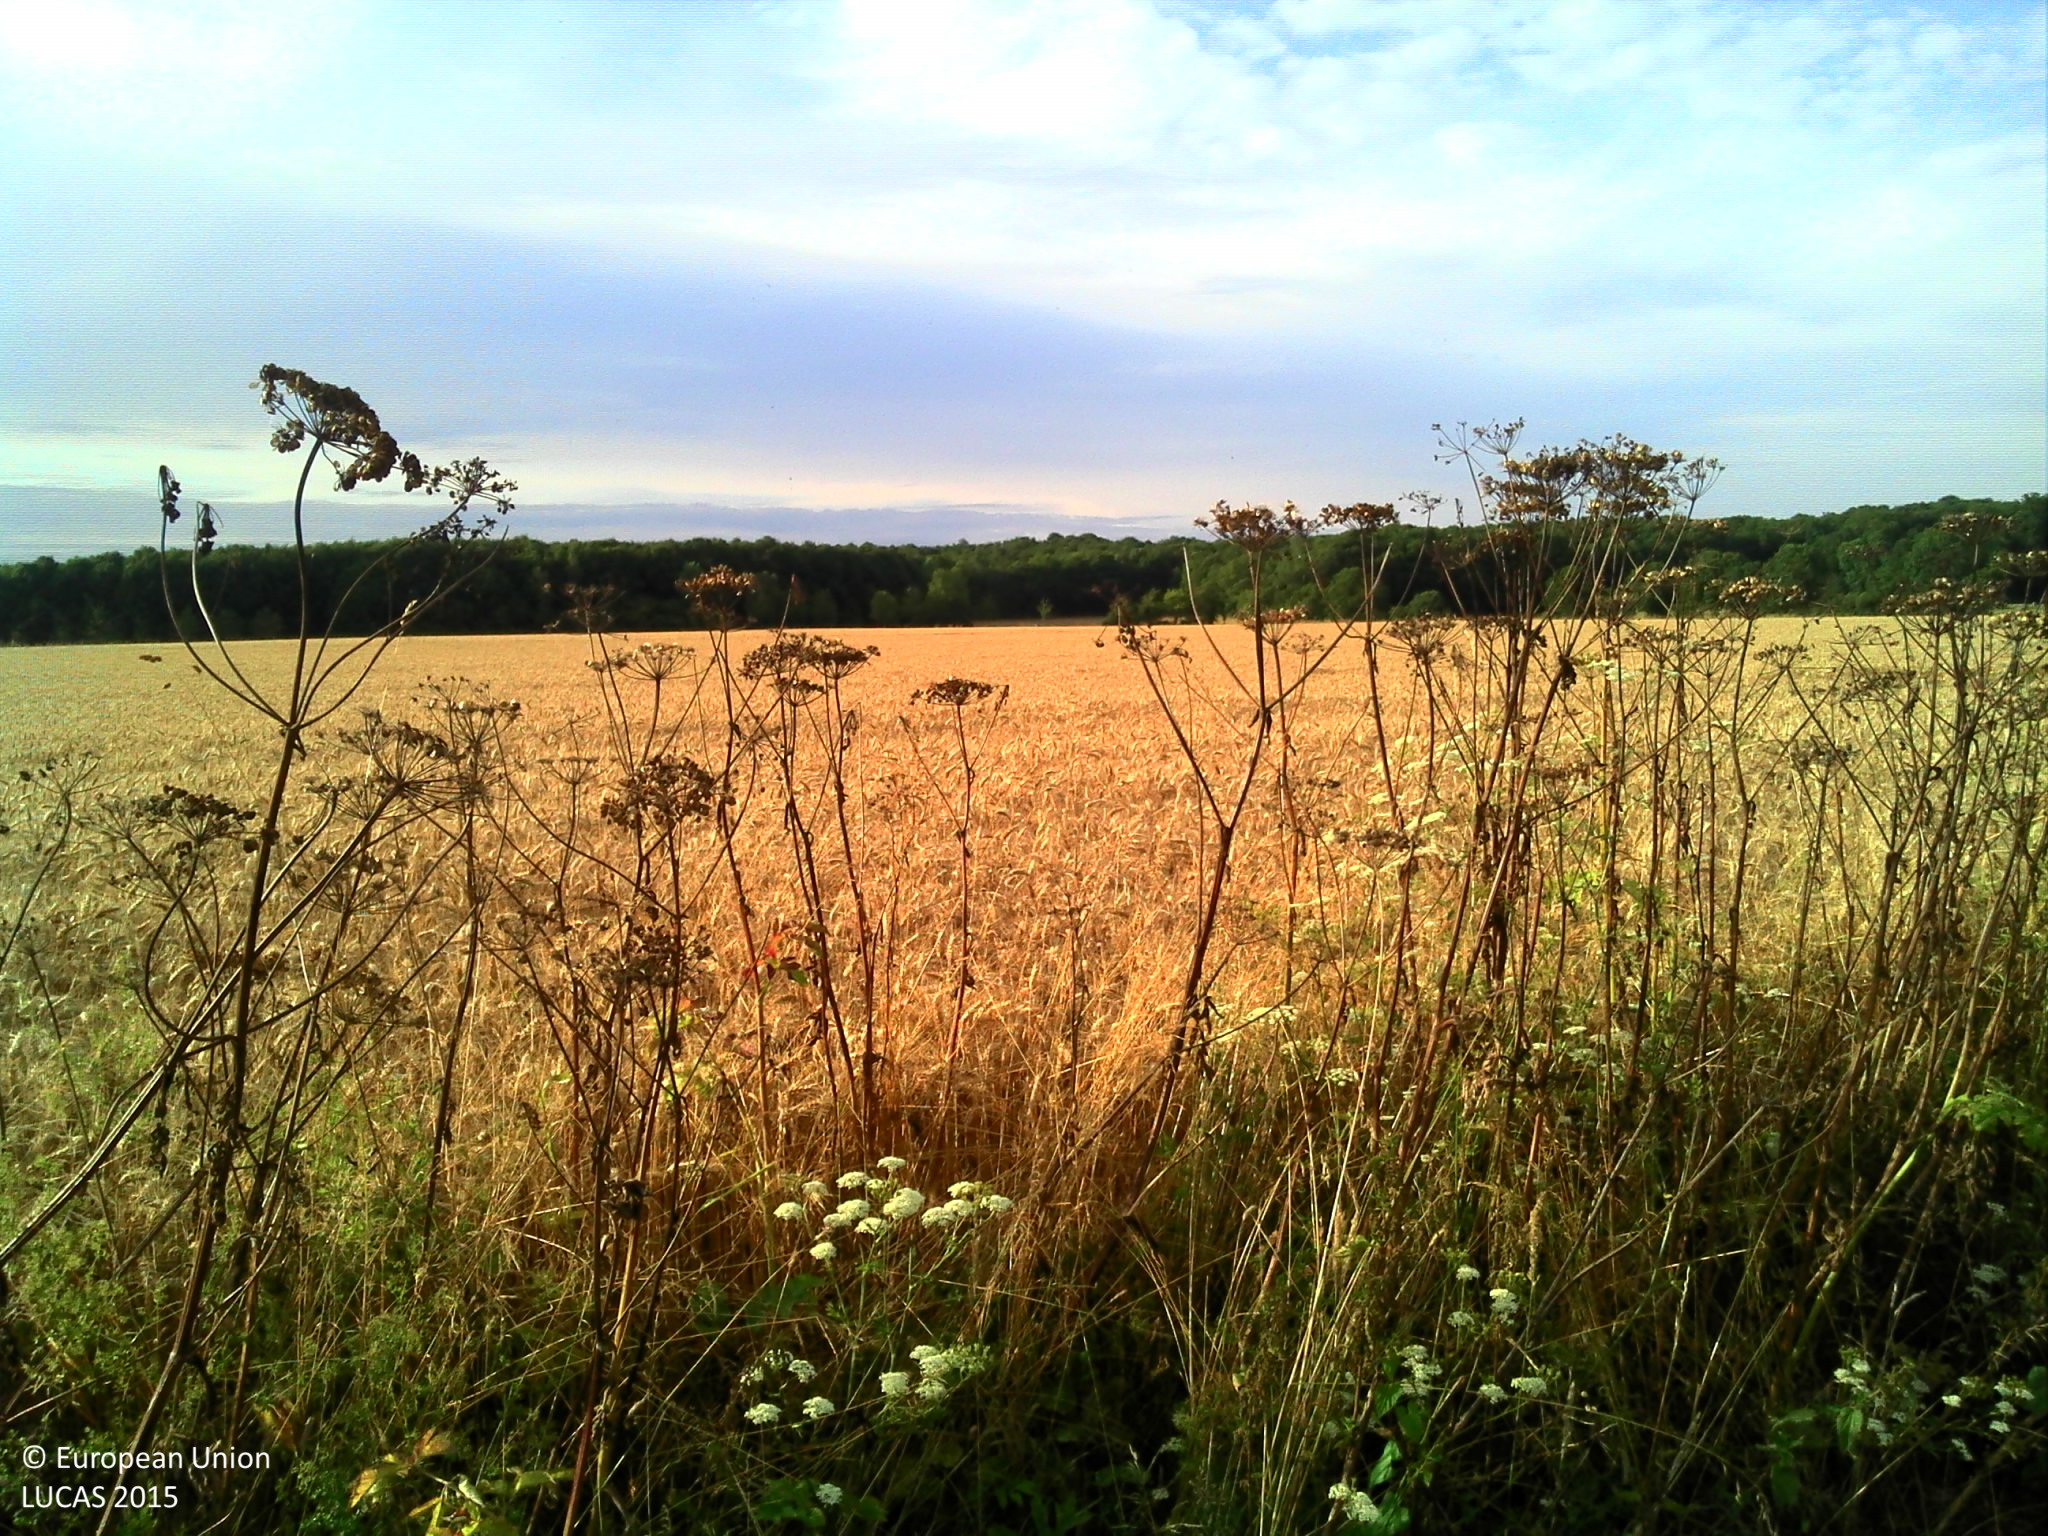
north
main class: Cropland
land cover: Common wheat
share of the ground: > 75 %
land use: Agriculture (excluding fallow land and kitchen gardens)
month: July
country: FR
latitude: 48.6671
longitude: 0.5381
